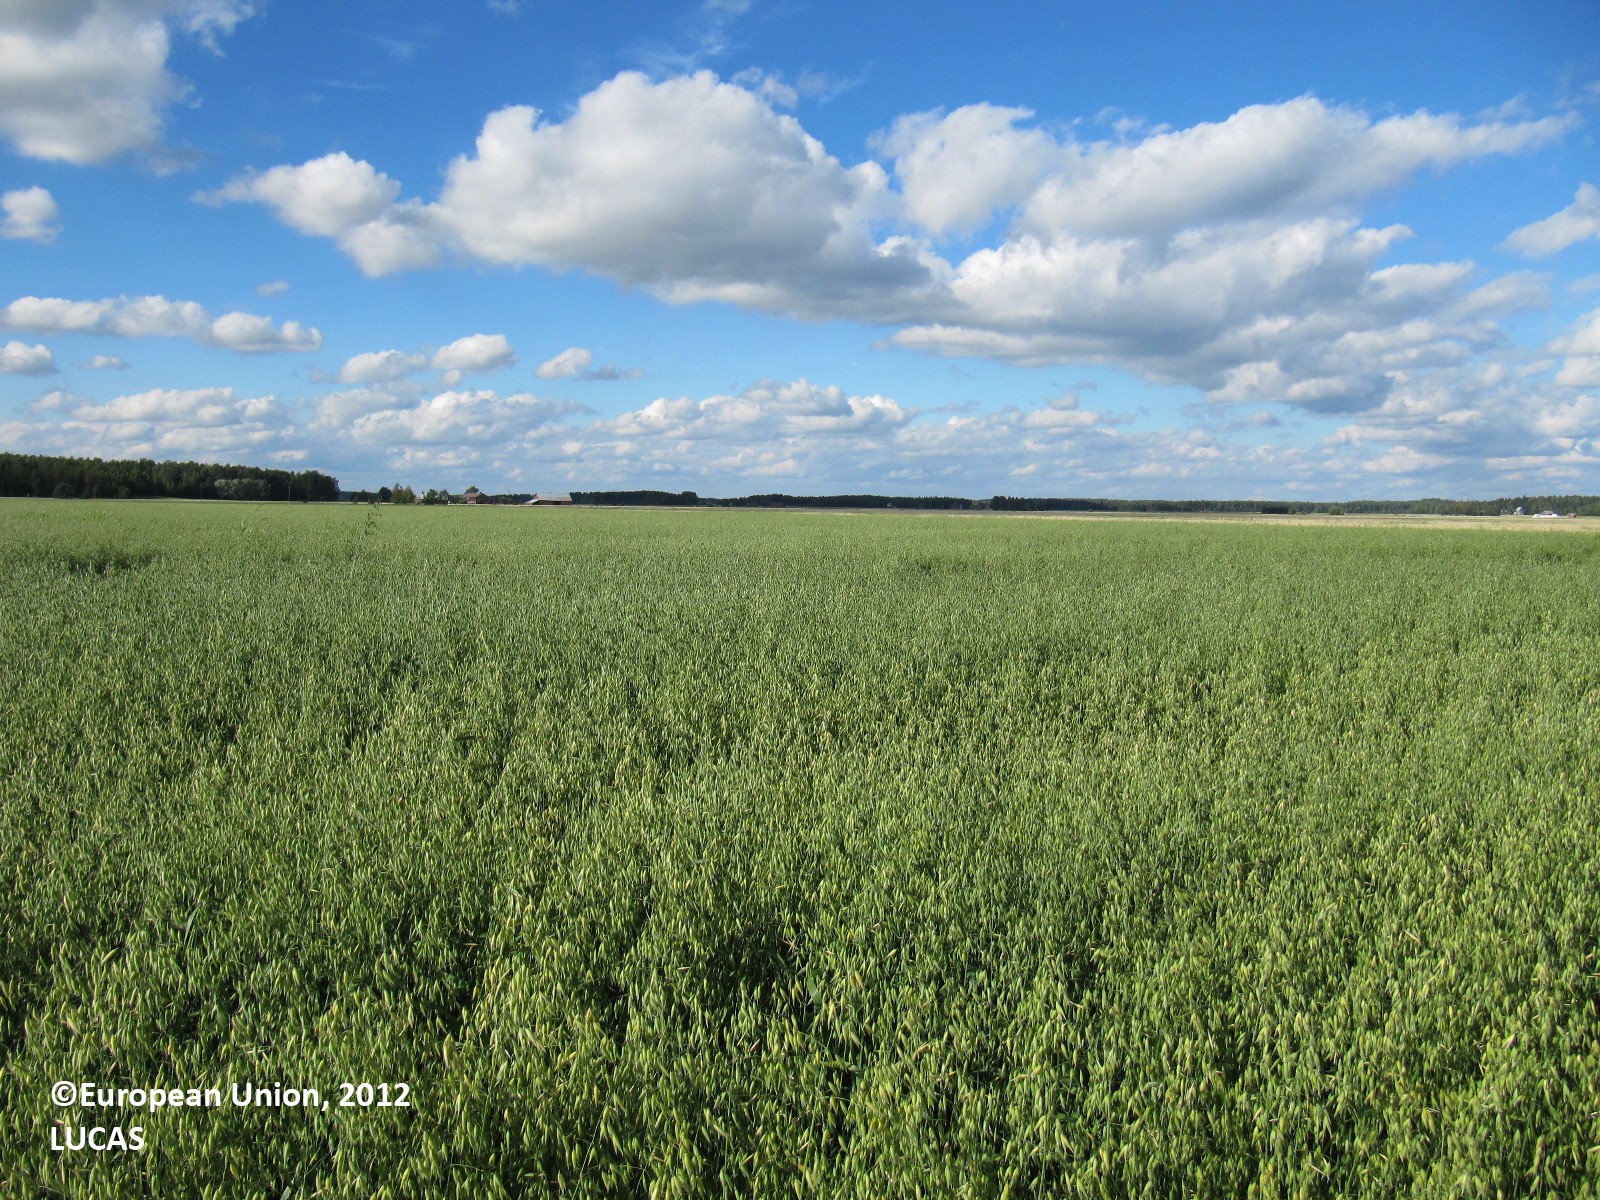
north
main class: Cropland
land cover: Oats
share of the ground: > 75 %
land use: Agriculture (excluding fallow land and kitchen gardens)
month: August
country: FI
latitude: 60.5036
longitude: 23.2463
